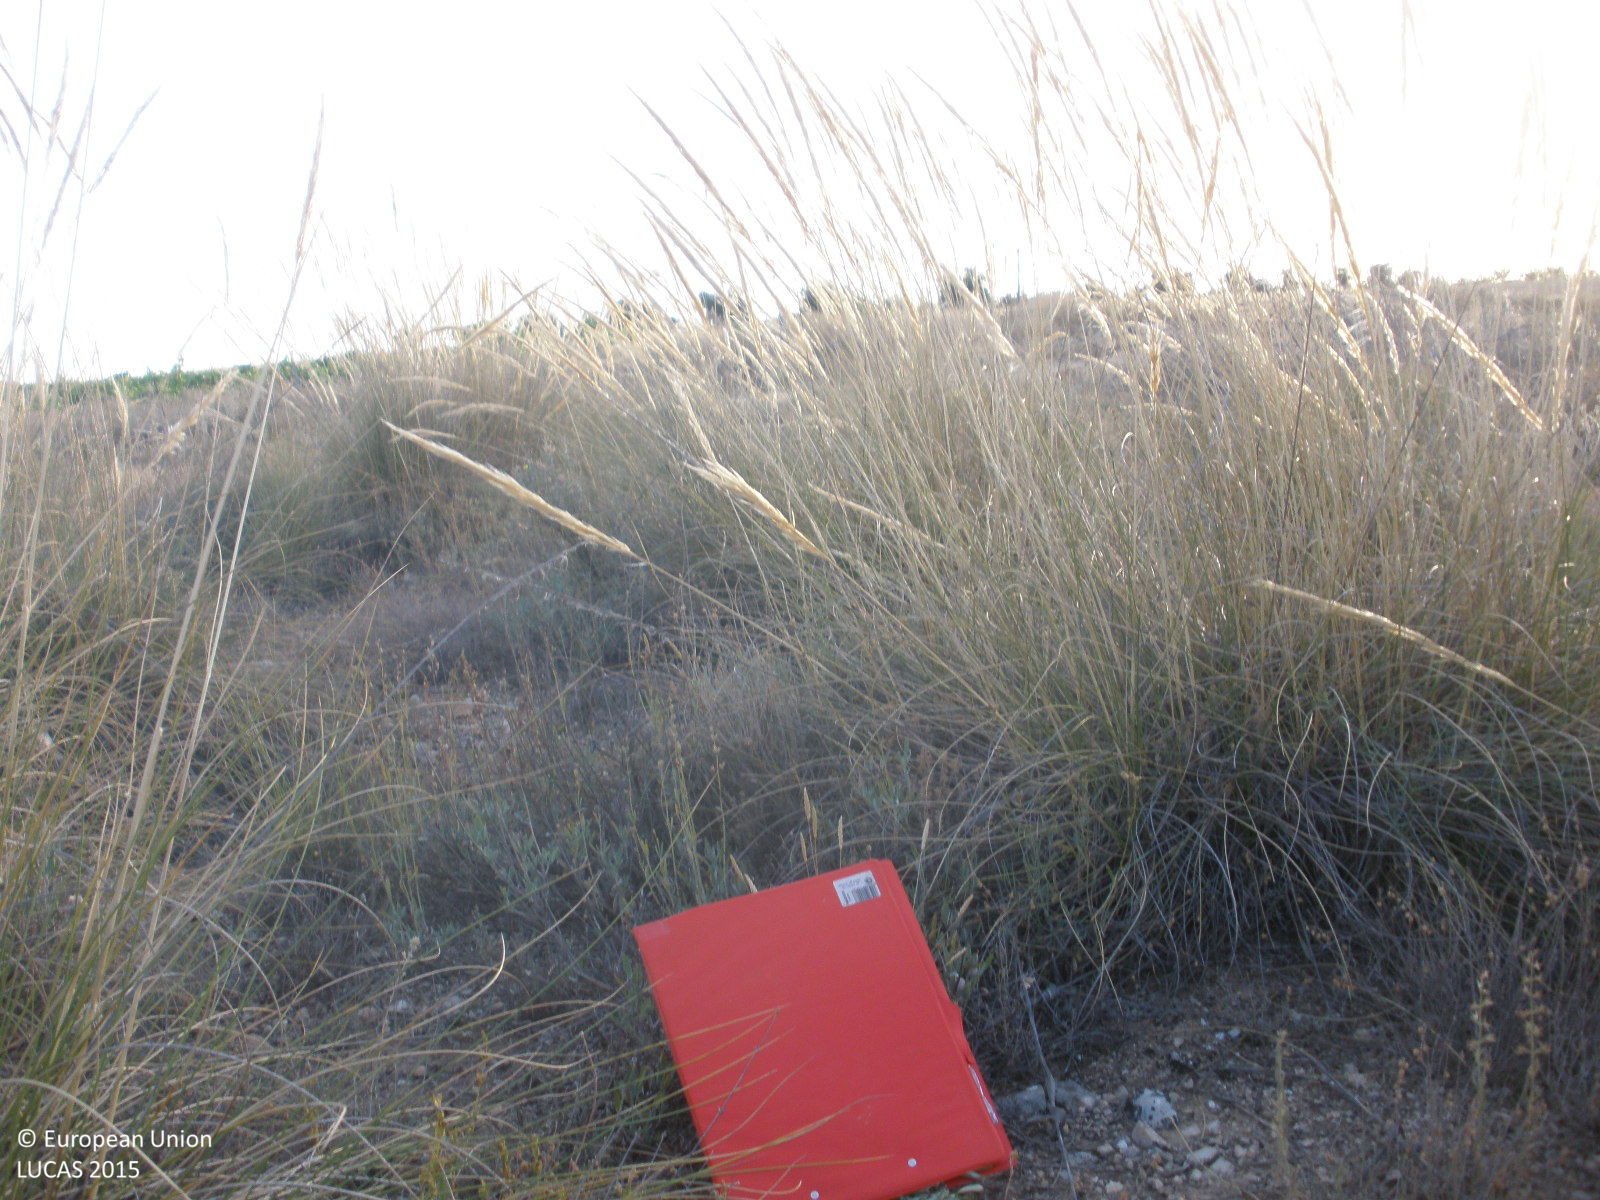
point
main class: Shrubland
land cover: Shrubland without tree cover
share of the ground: 25 - 50 %
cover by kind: herbaceous plants 50 %, shrubs 40 %, consolidated bare surface 10 %
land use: Semi-natural and natural areas not in use
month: July
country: ES
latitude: 40.0004
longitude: -3.4168
